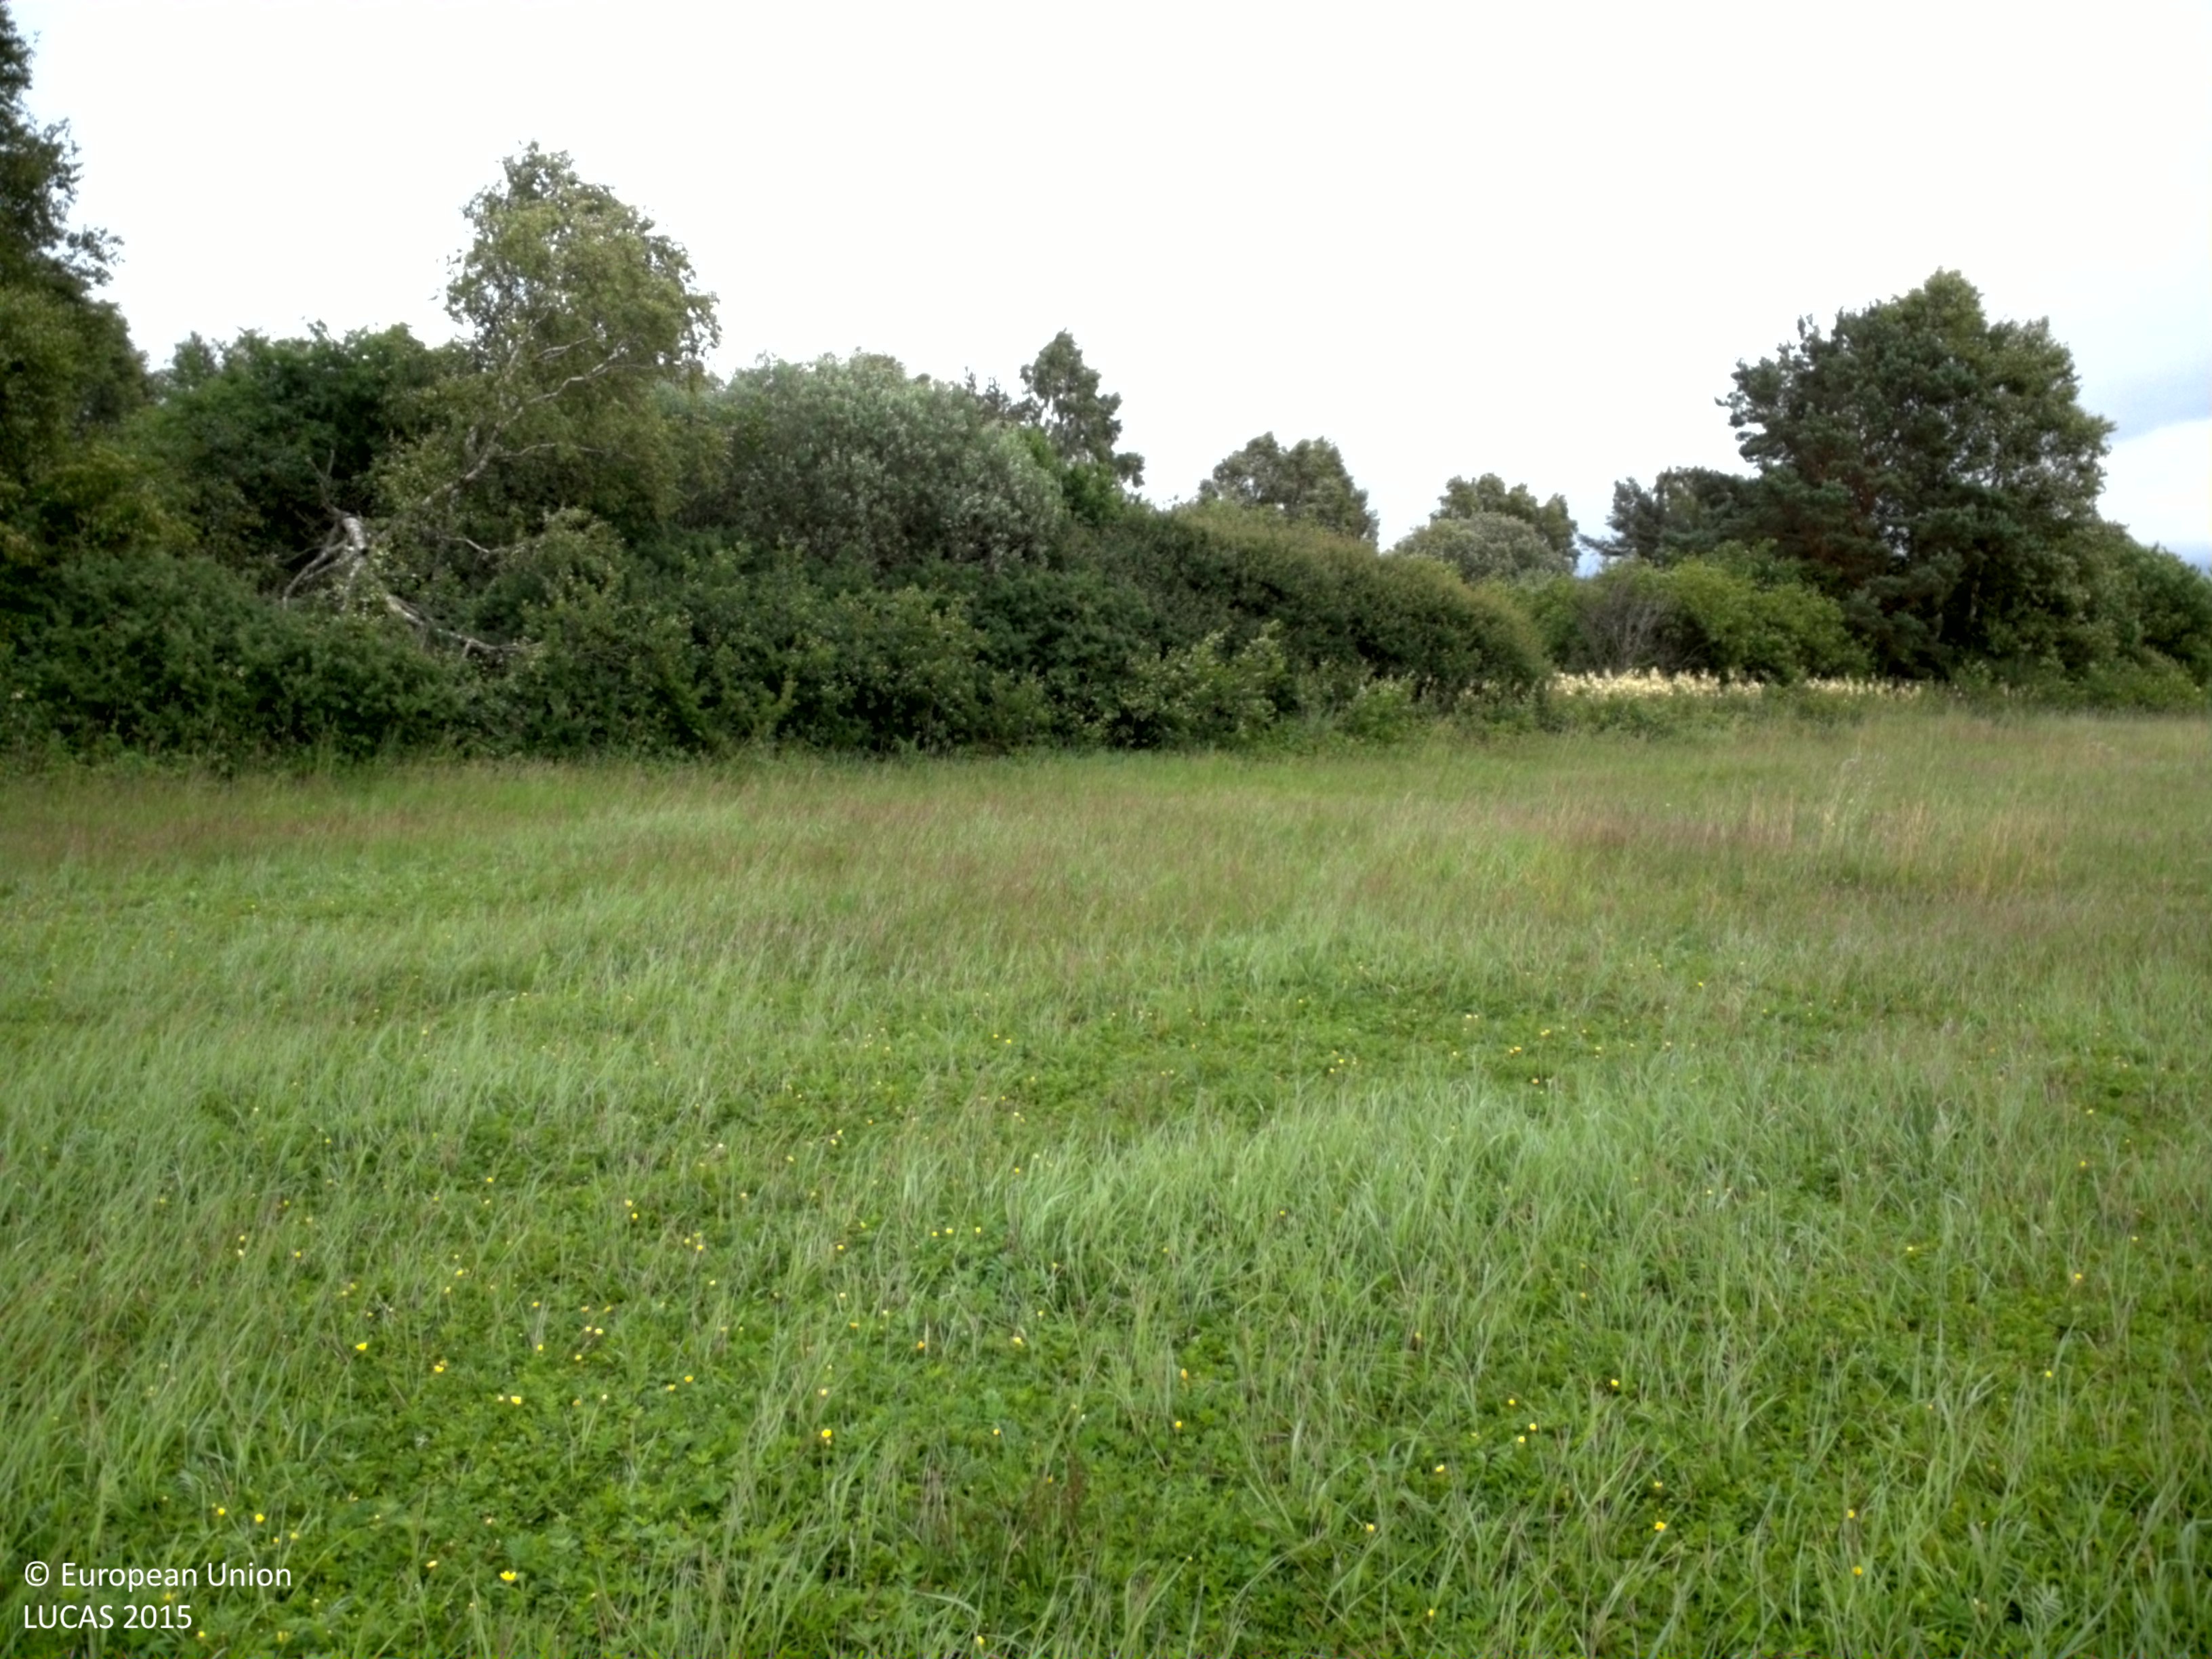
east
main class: Grassland
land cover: Grassland without tree/shrub cover
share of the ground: > 75 %
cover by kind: herbaceous plants 100 %
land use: Agriculture (excluding fallow land and kitchen gardens)
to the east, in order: Grassland without tree/shrub cover; Ditches and canals; Abandoned hedges; Broadleaved woodland; Temporary grasslands; Abandoned hedges; Grassland with sparse tree/shrub cover
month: July
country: SE
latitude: 57.4429
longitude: 18.2211
